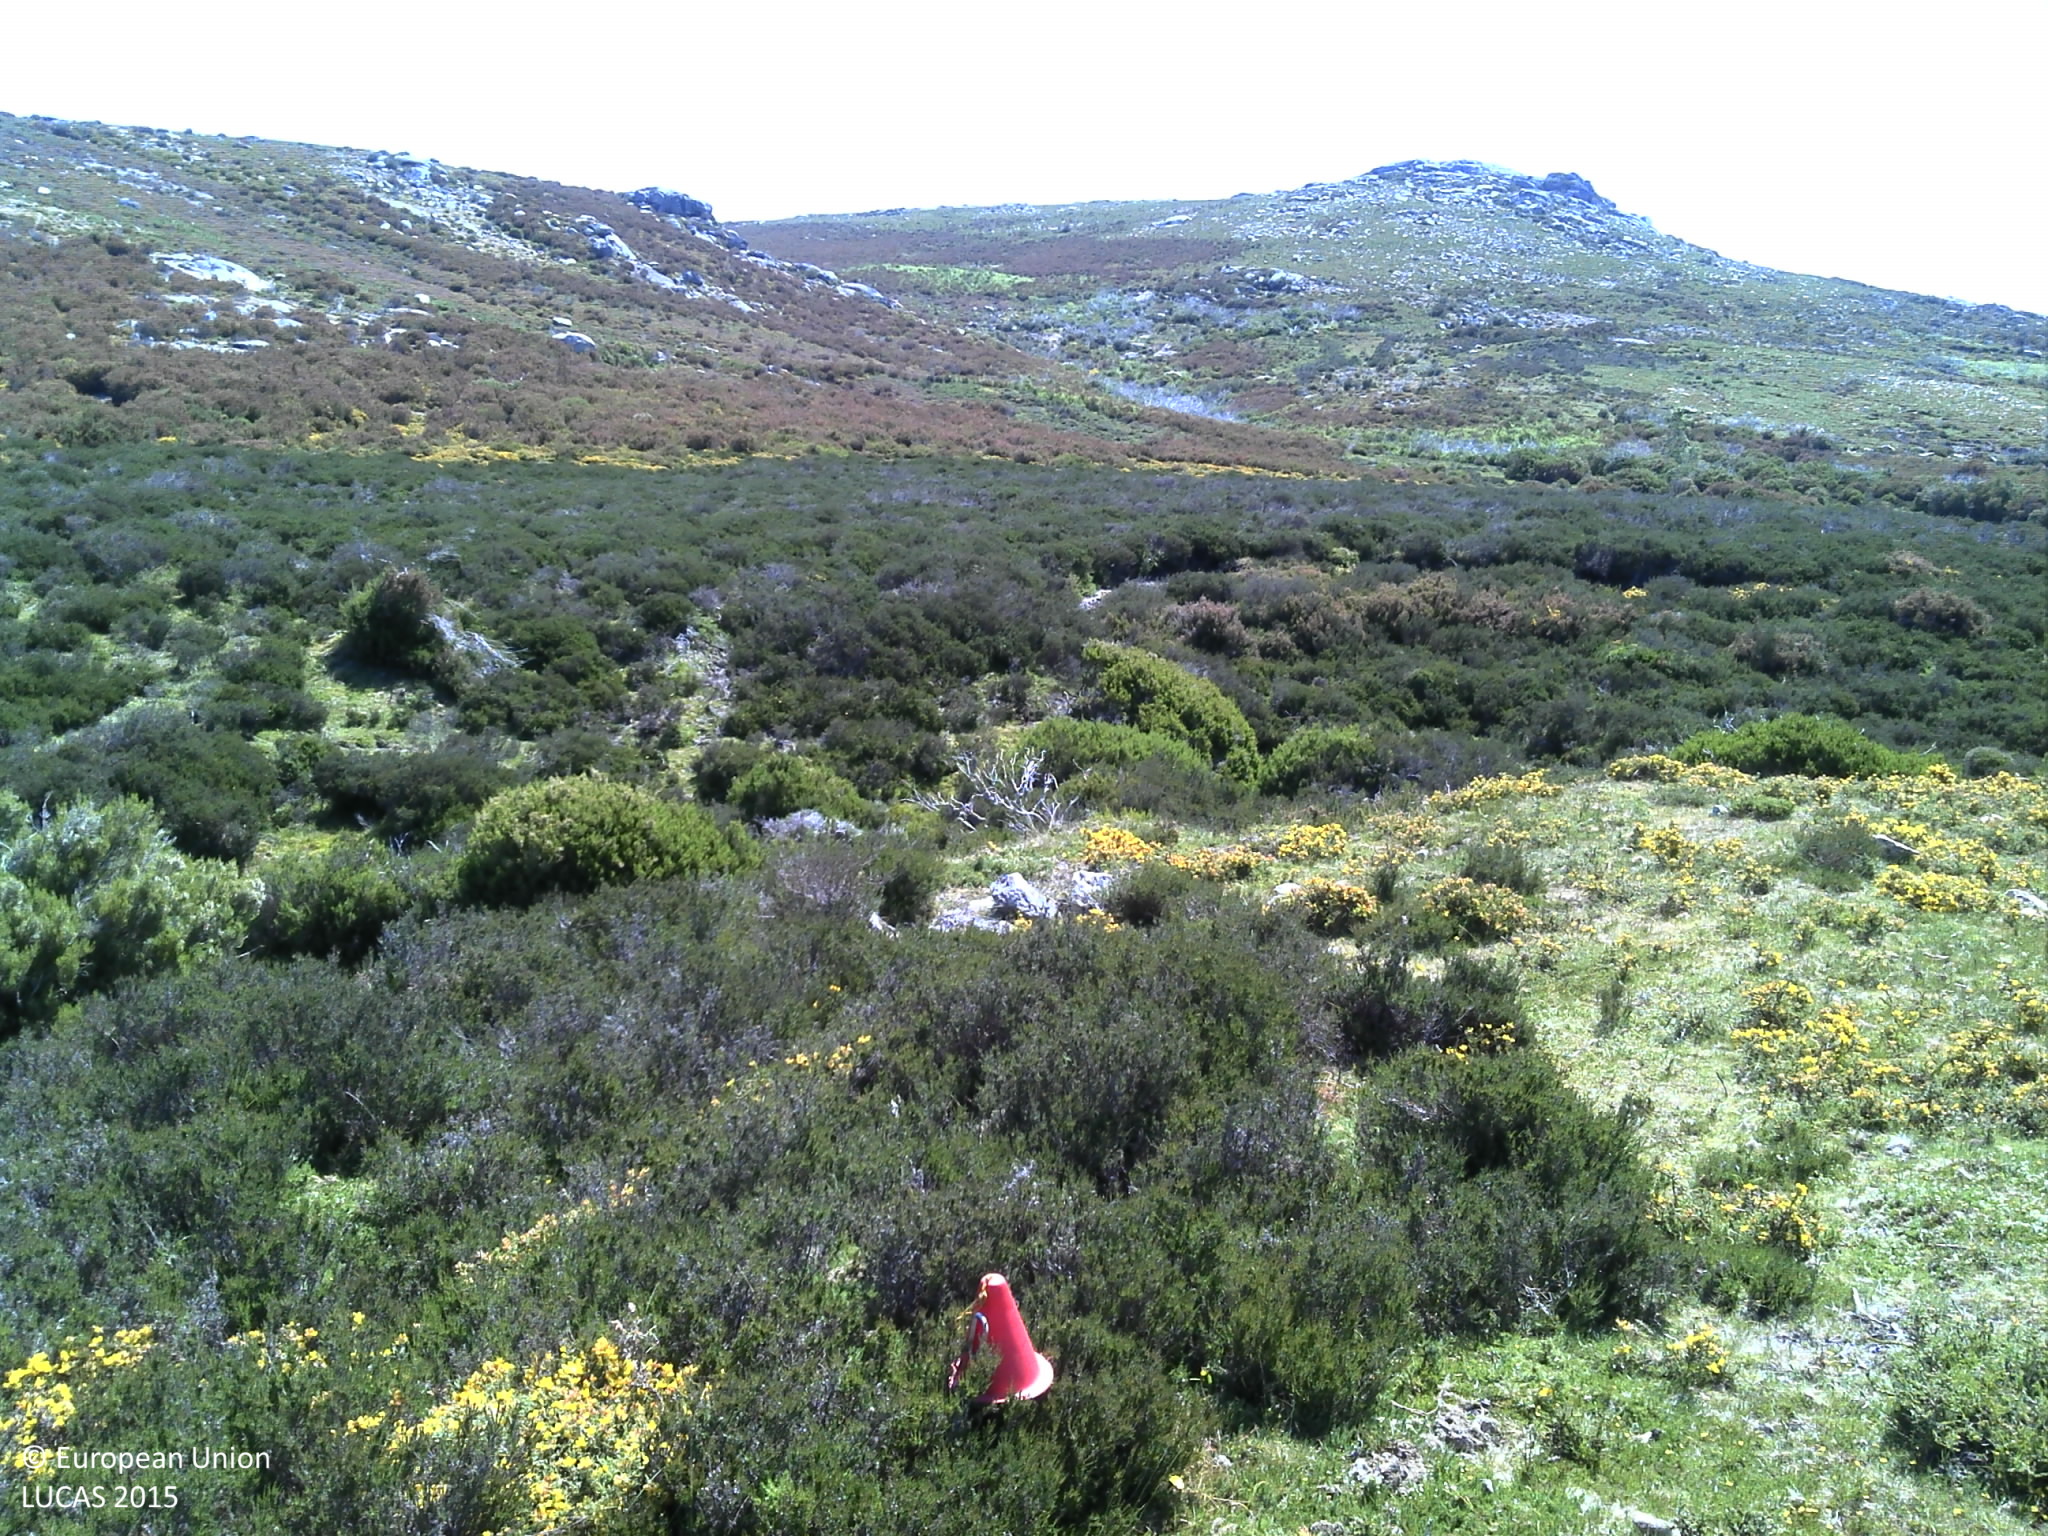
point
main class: Shrubland
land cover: Shrubland without tree cover
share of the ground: 50 - 75 %
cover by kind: shrubs 70 %, herbaceous plants 20 %, unconsolidated bare surface 10 %
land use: Agriculture (excluding fallow land and kitchen gardens)
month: June
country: PT
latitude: 41.9511
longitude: -8.2878
